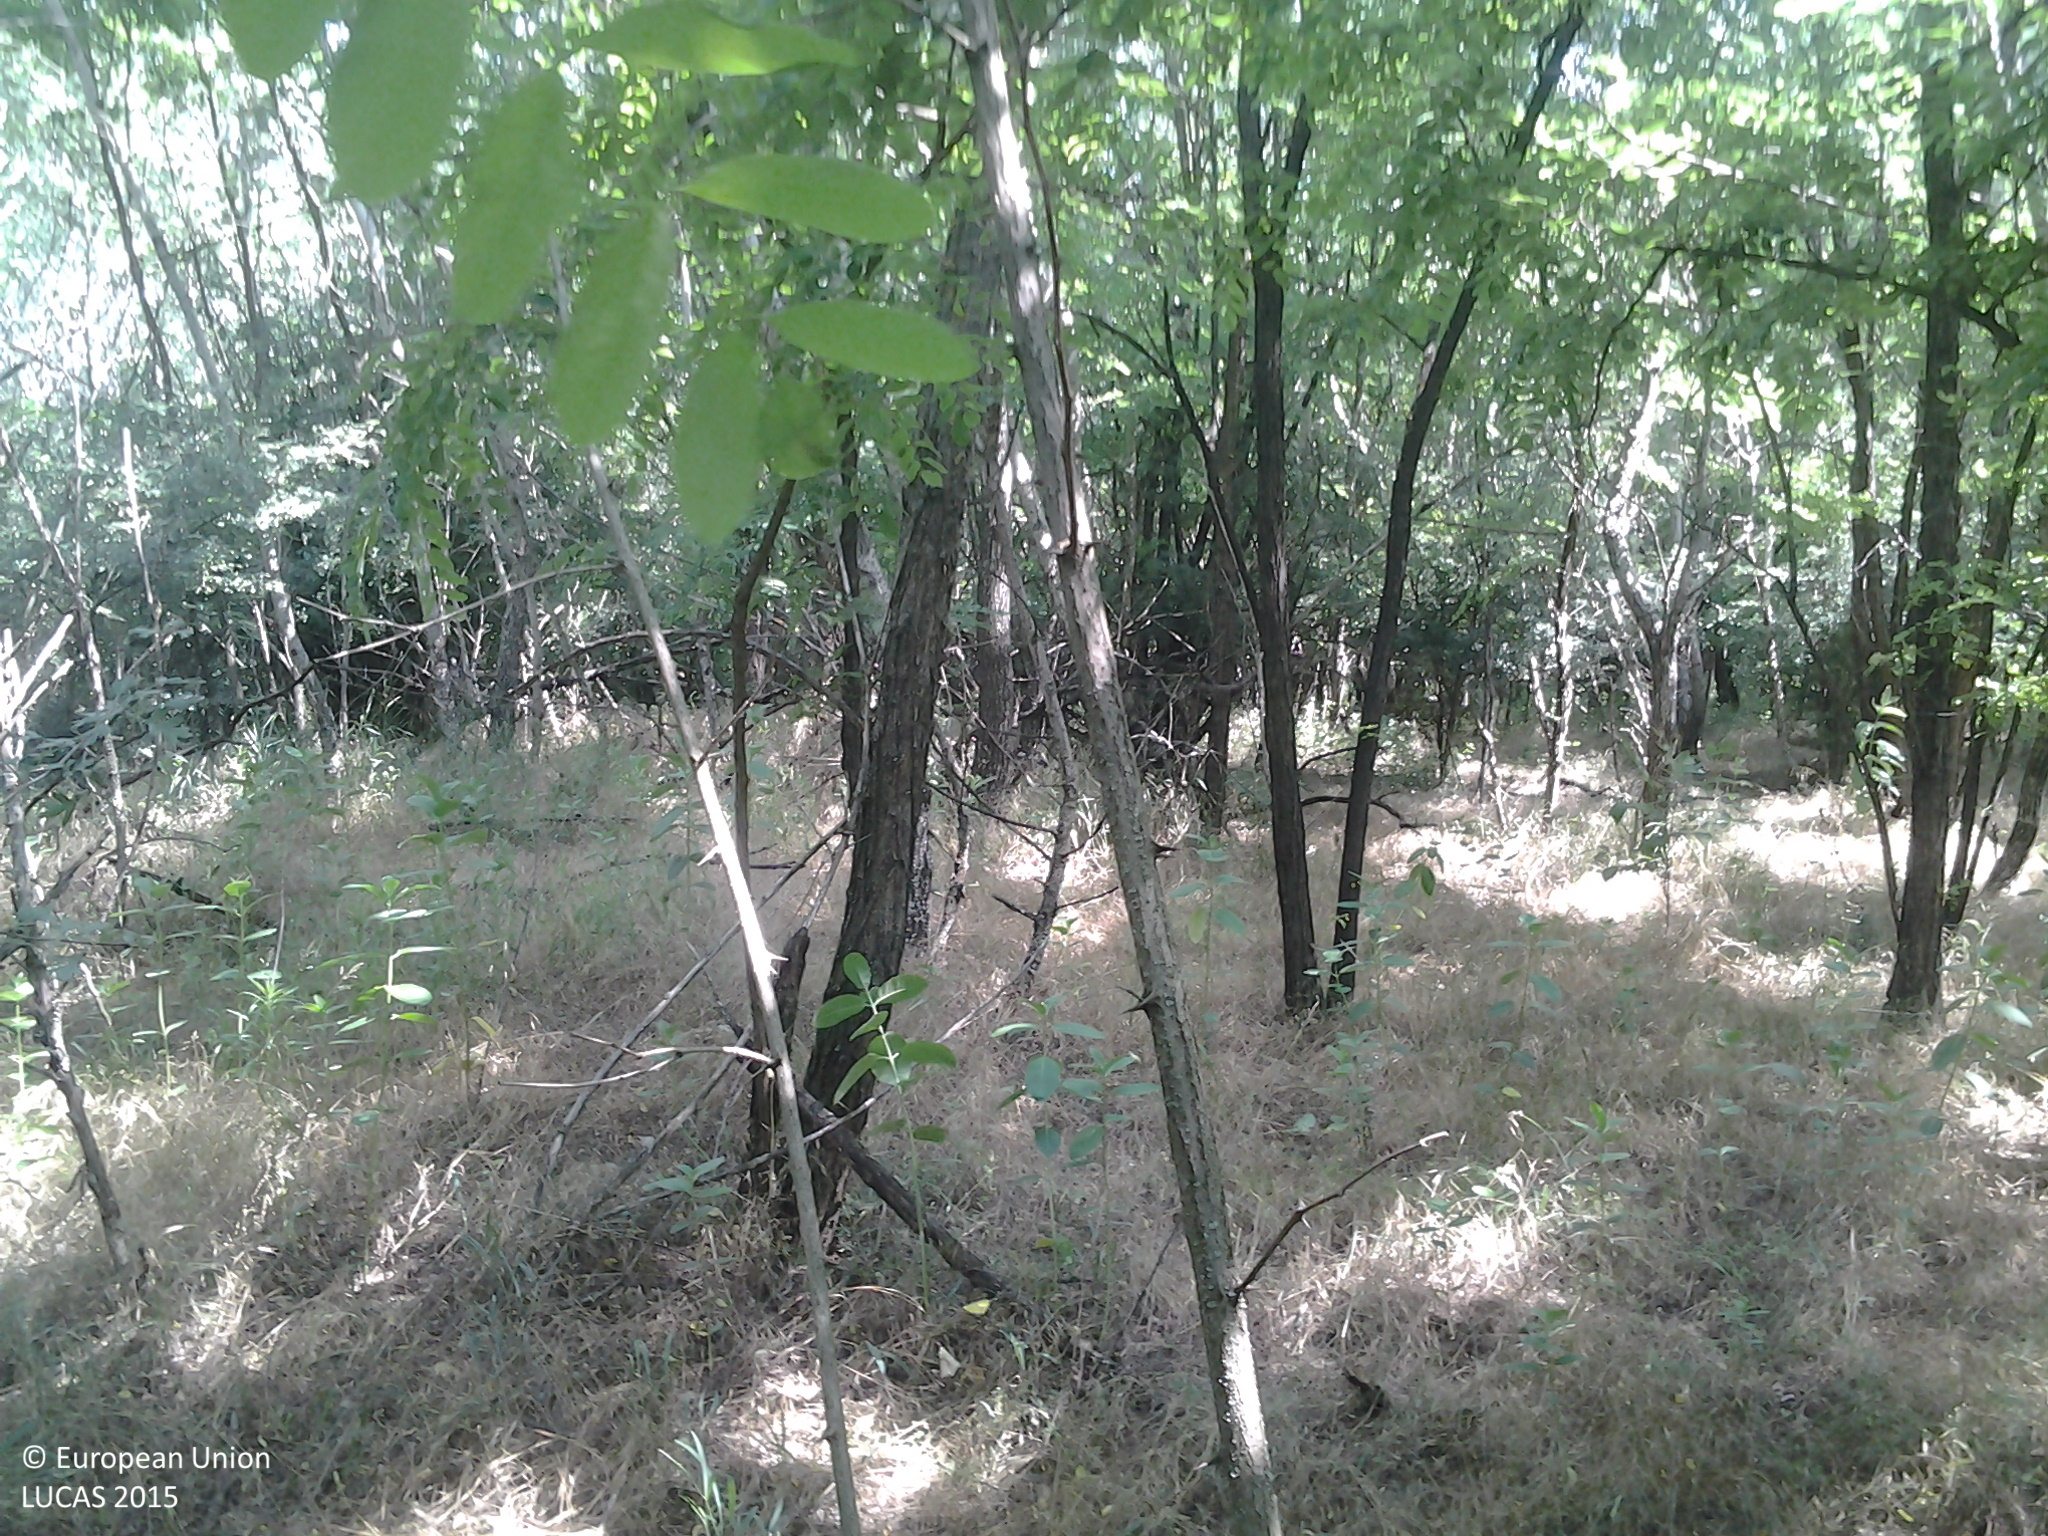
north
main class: Woodland
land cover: Broadleaved woodland
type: mesophytic deciduous forest
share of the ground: > 75 %
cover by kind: broadleaved forest trees 95 %, shrubs 5 %
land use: Forestry
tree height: > 5 m
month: June
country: HU
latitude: 46.8047
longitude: 19.6246
